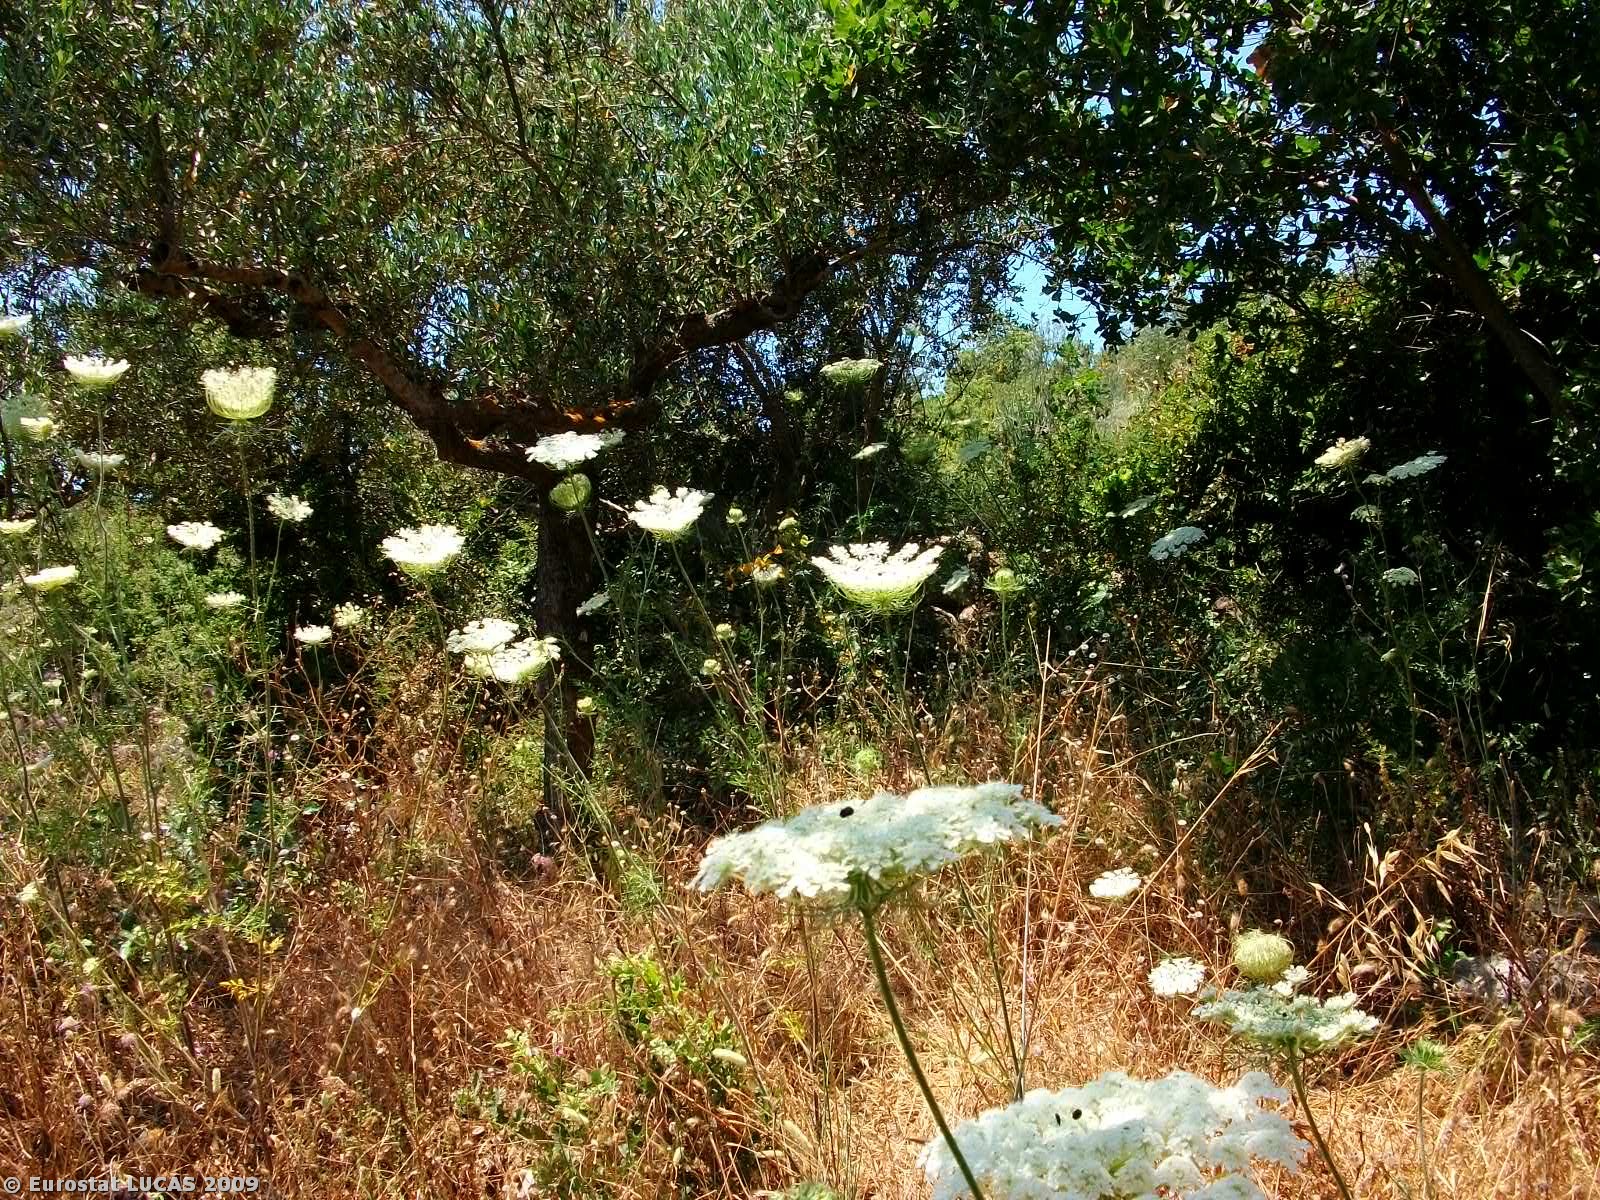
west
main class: Cropland
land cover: Olive groves
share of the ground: 50 - 75 %
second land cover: Grassland with sparse tree/shrub cover
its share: > 75 %
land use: Agriculture (excluding fallow land and kitchen gardens)
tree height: < 5 m
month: June
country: GR
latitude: 36.8570
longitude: 22.2783
